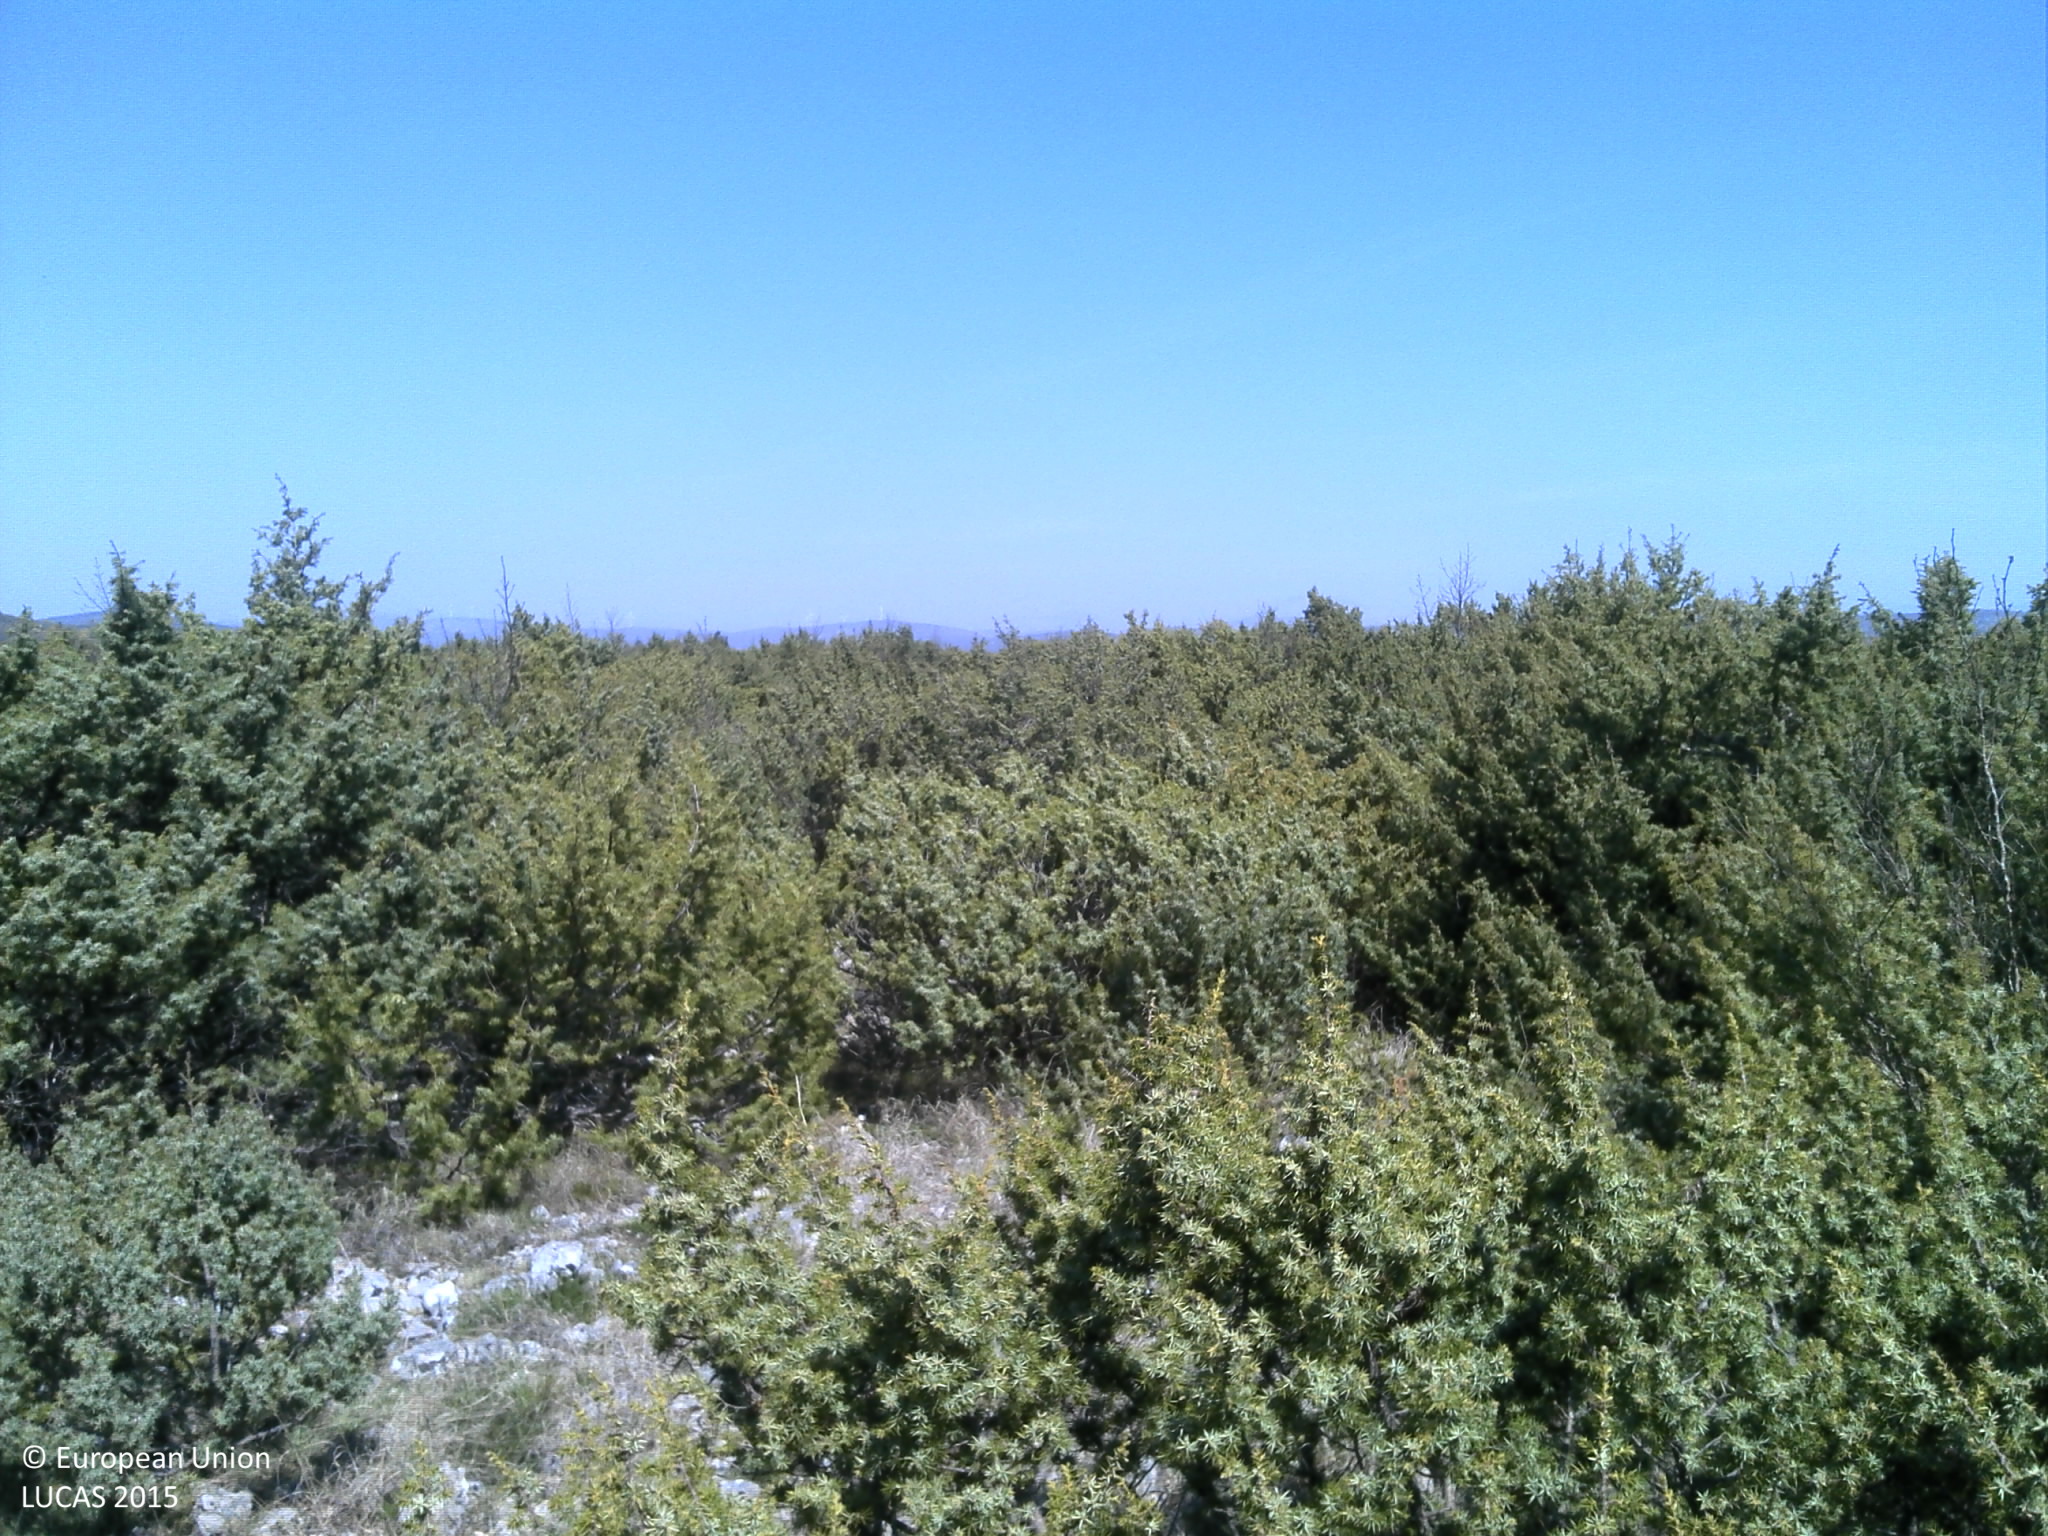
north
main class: Shrubland
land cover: Shrubland with sparse tree cover
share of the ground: > 75 %
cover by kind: shrubs 70 %, unconsolidated bare surface 10 %, broadleaved forest trees 5 %, consolidated bare surface 5 %
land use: Semi-natural and natural areas not in use
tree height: < 5 m
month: April
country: HR
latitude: 43.9513
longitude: 15.8358
